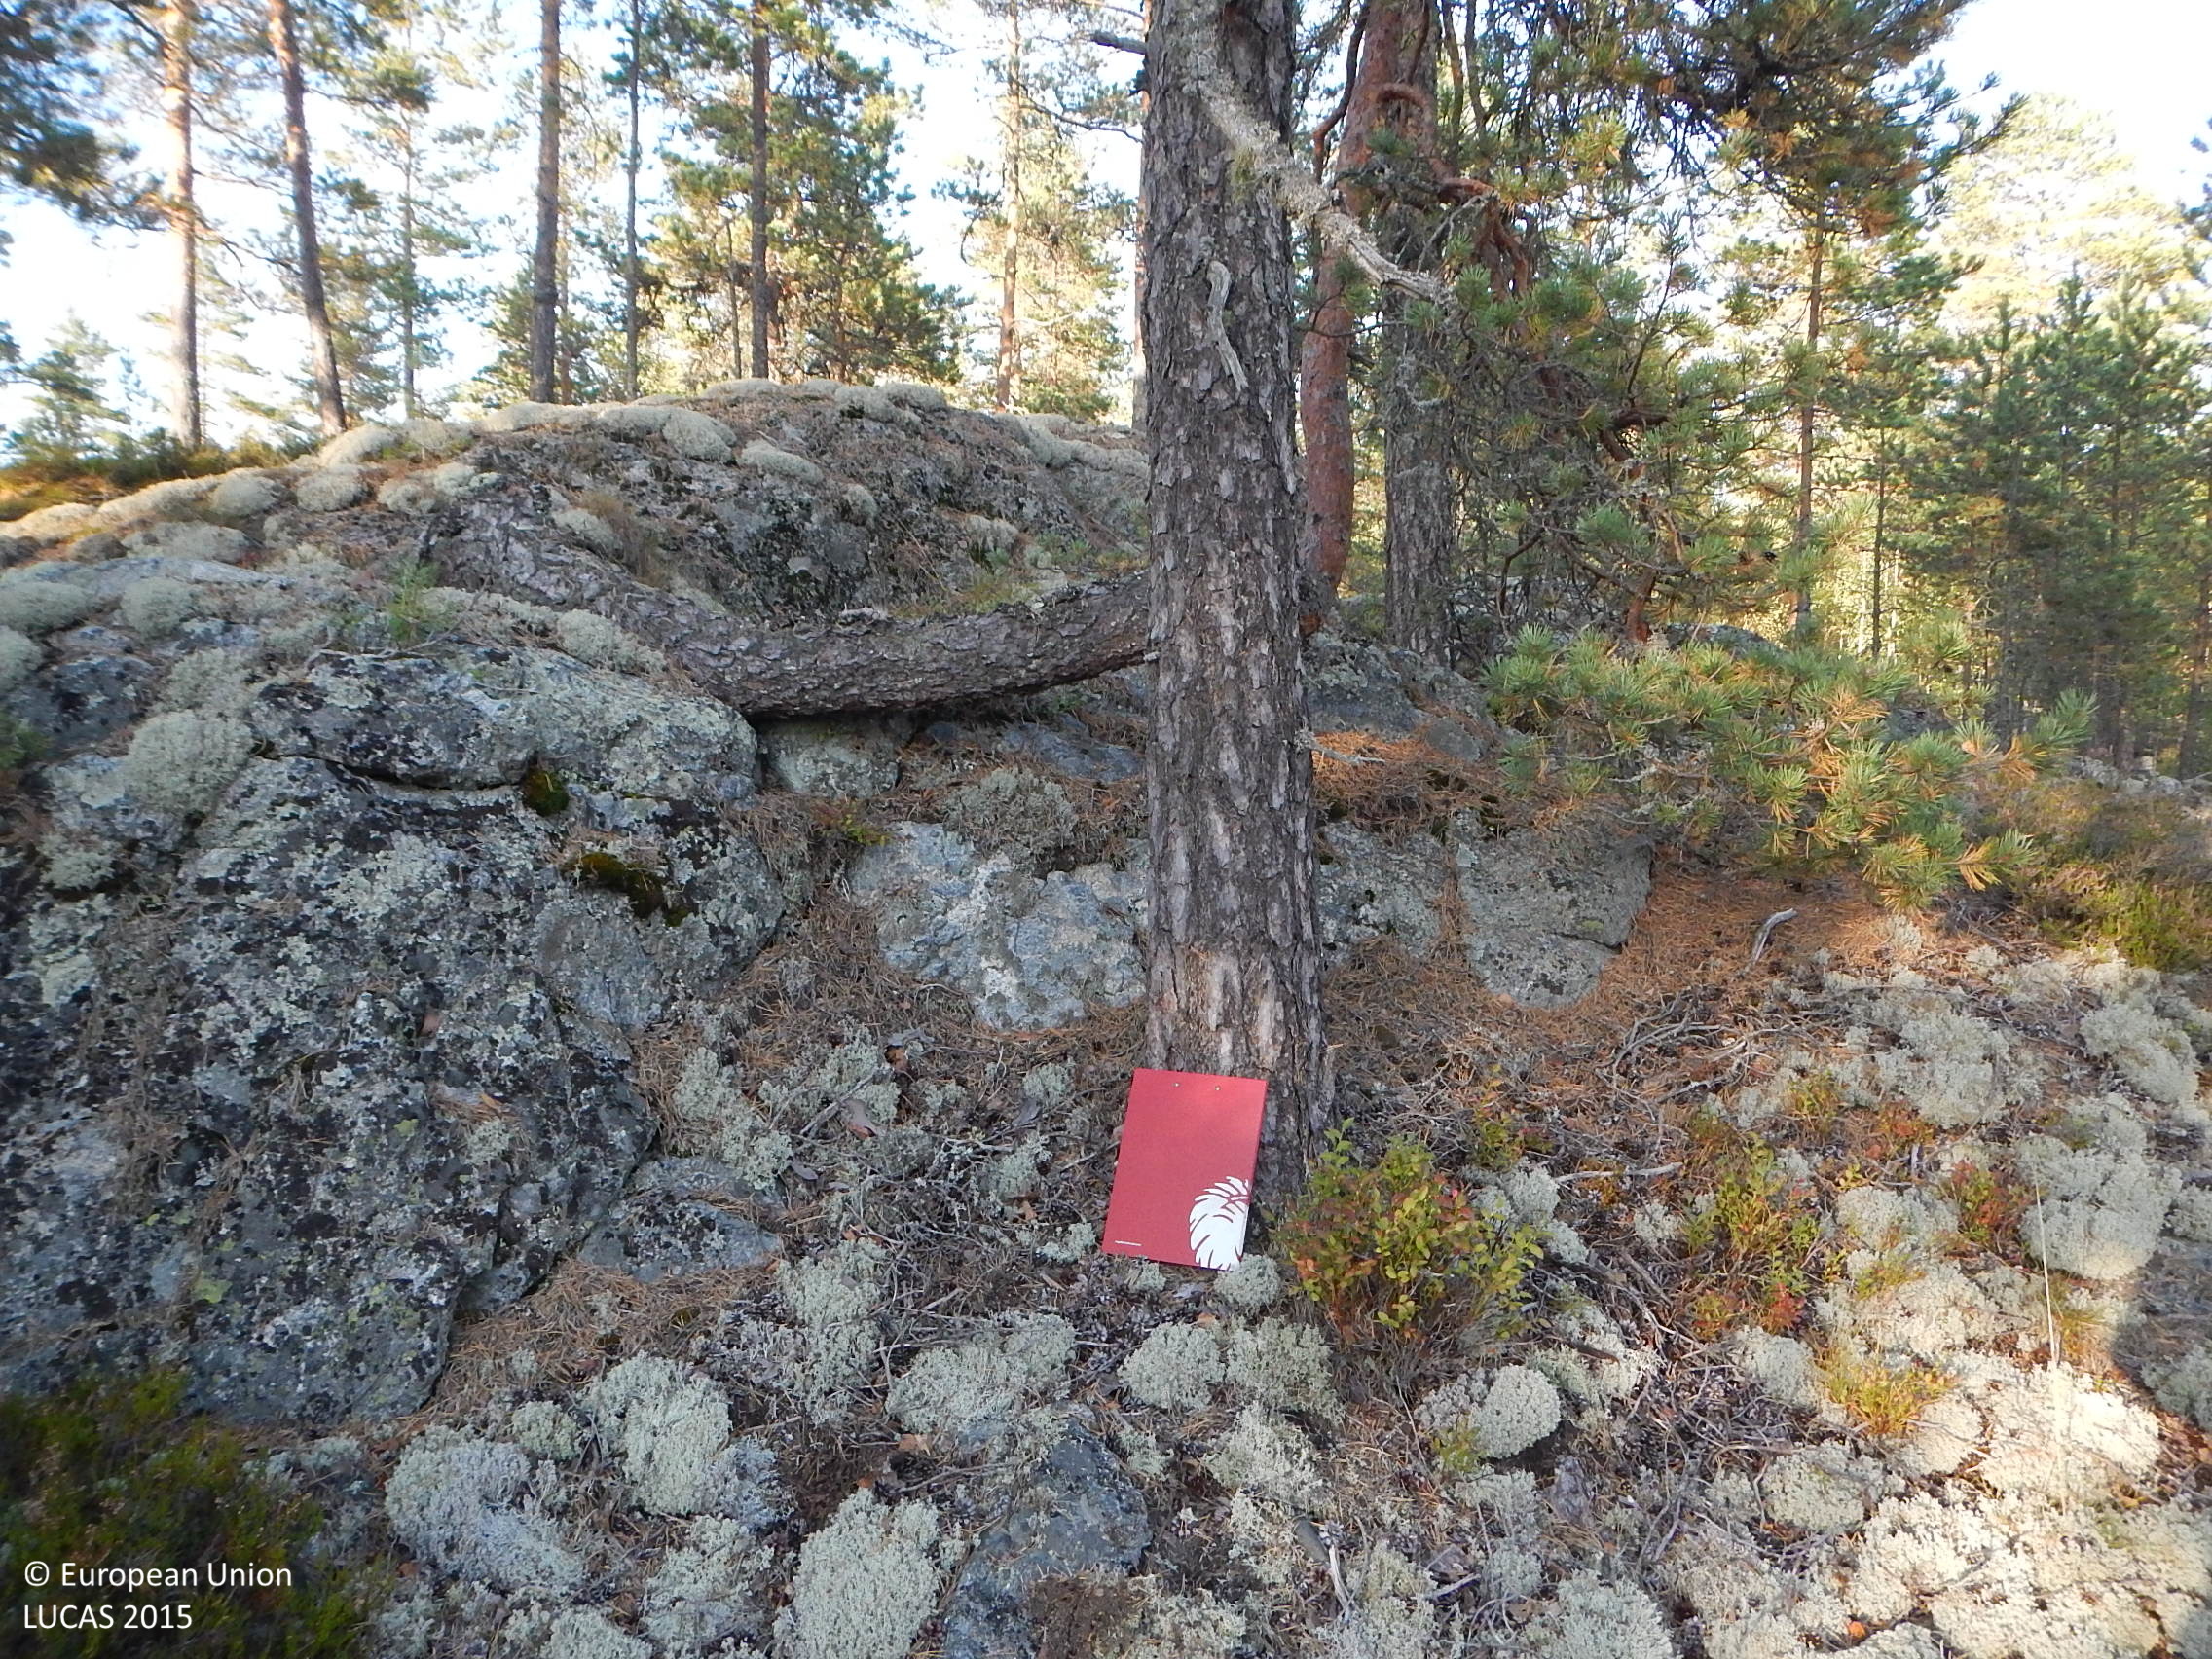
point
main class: Woodland
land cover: Pine dominated coniferous woodland
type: boreal forest
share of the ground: 25 - 50 %
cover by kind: coniferous forest trees 40 %, lichens and mosses 40 %, shrubs 10 %, consolidated bare surface 10 %
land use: Forestry
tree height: > 5 m
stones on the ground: < 10 %
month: September
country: FI
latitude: 61.6371
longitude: 22.6508
